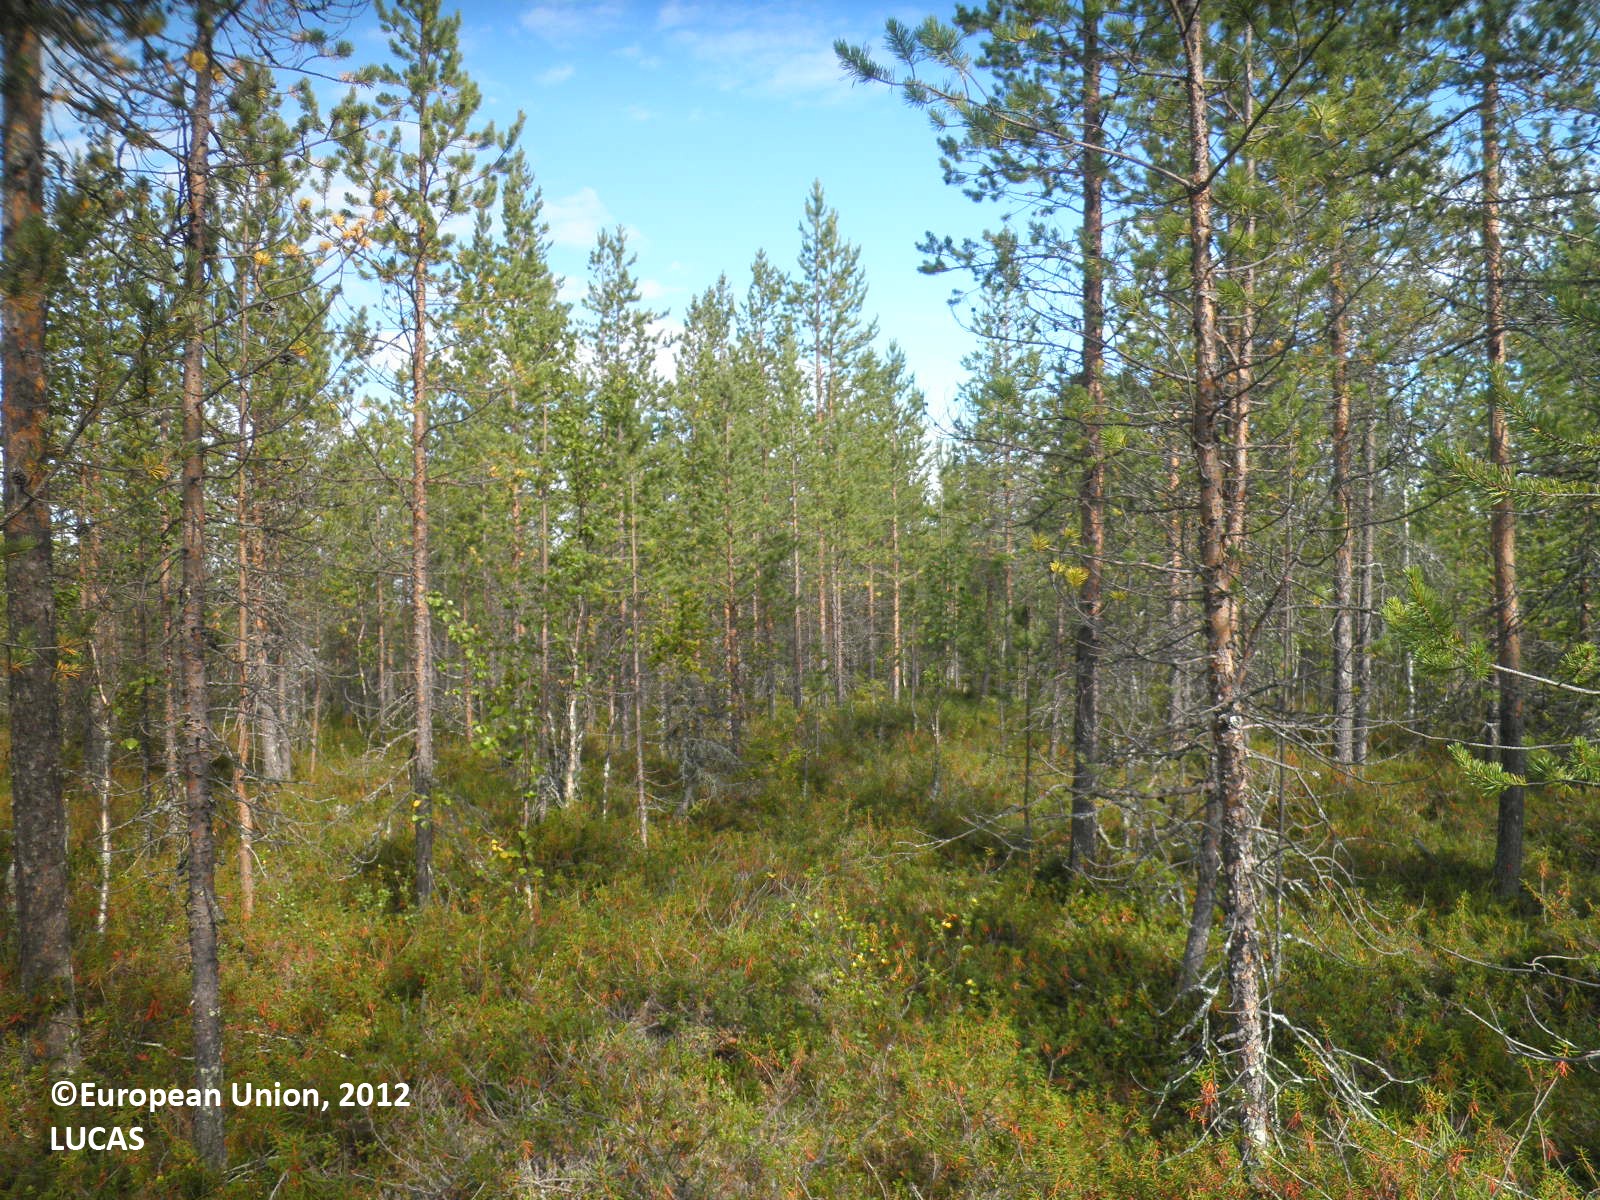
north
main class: Woodland
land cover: Pine dominated coniferous woodland
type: boreal forest
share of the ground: 25 - 50 %
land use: Forestry
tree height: > 5 m
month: August
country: FI
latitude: 67.4777
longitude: 26.9505
